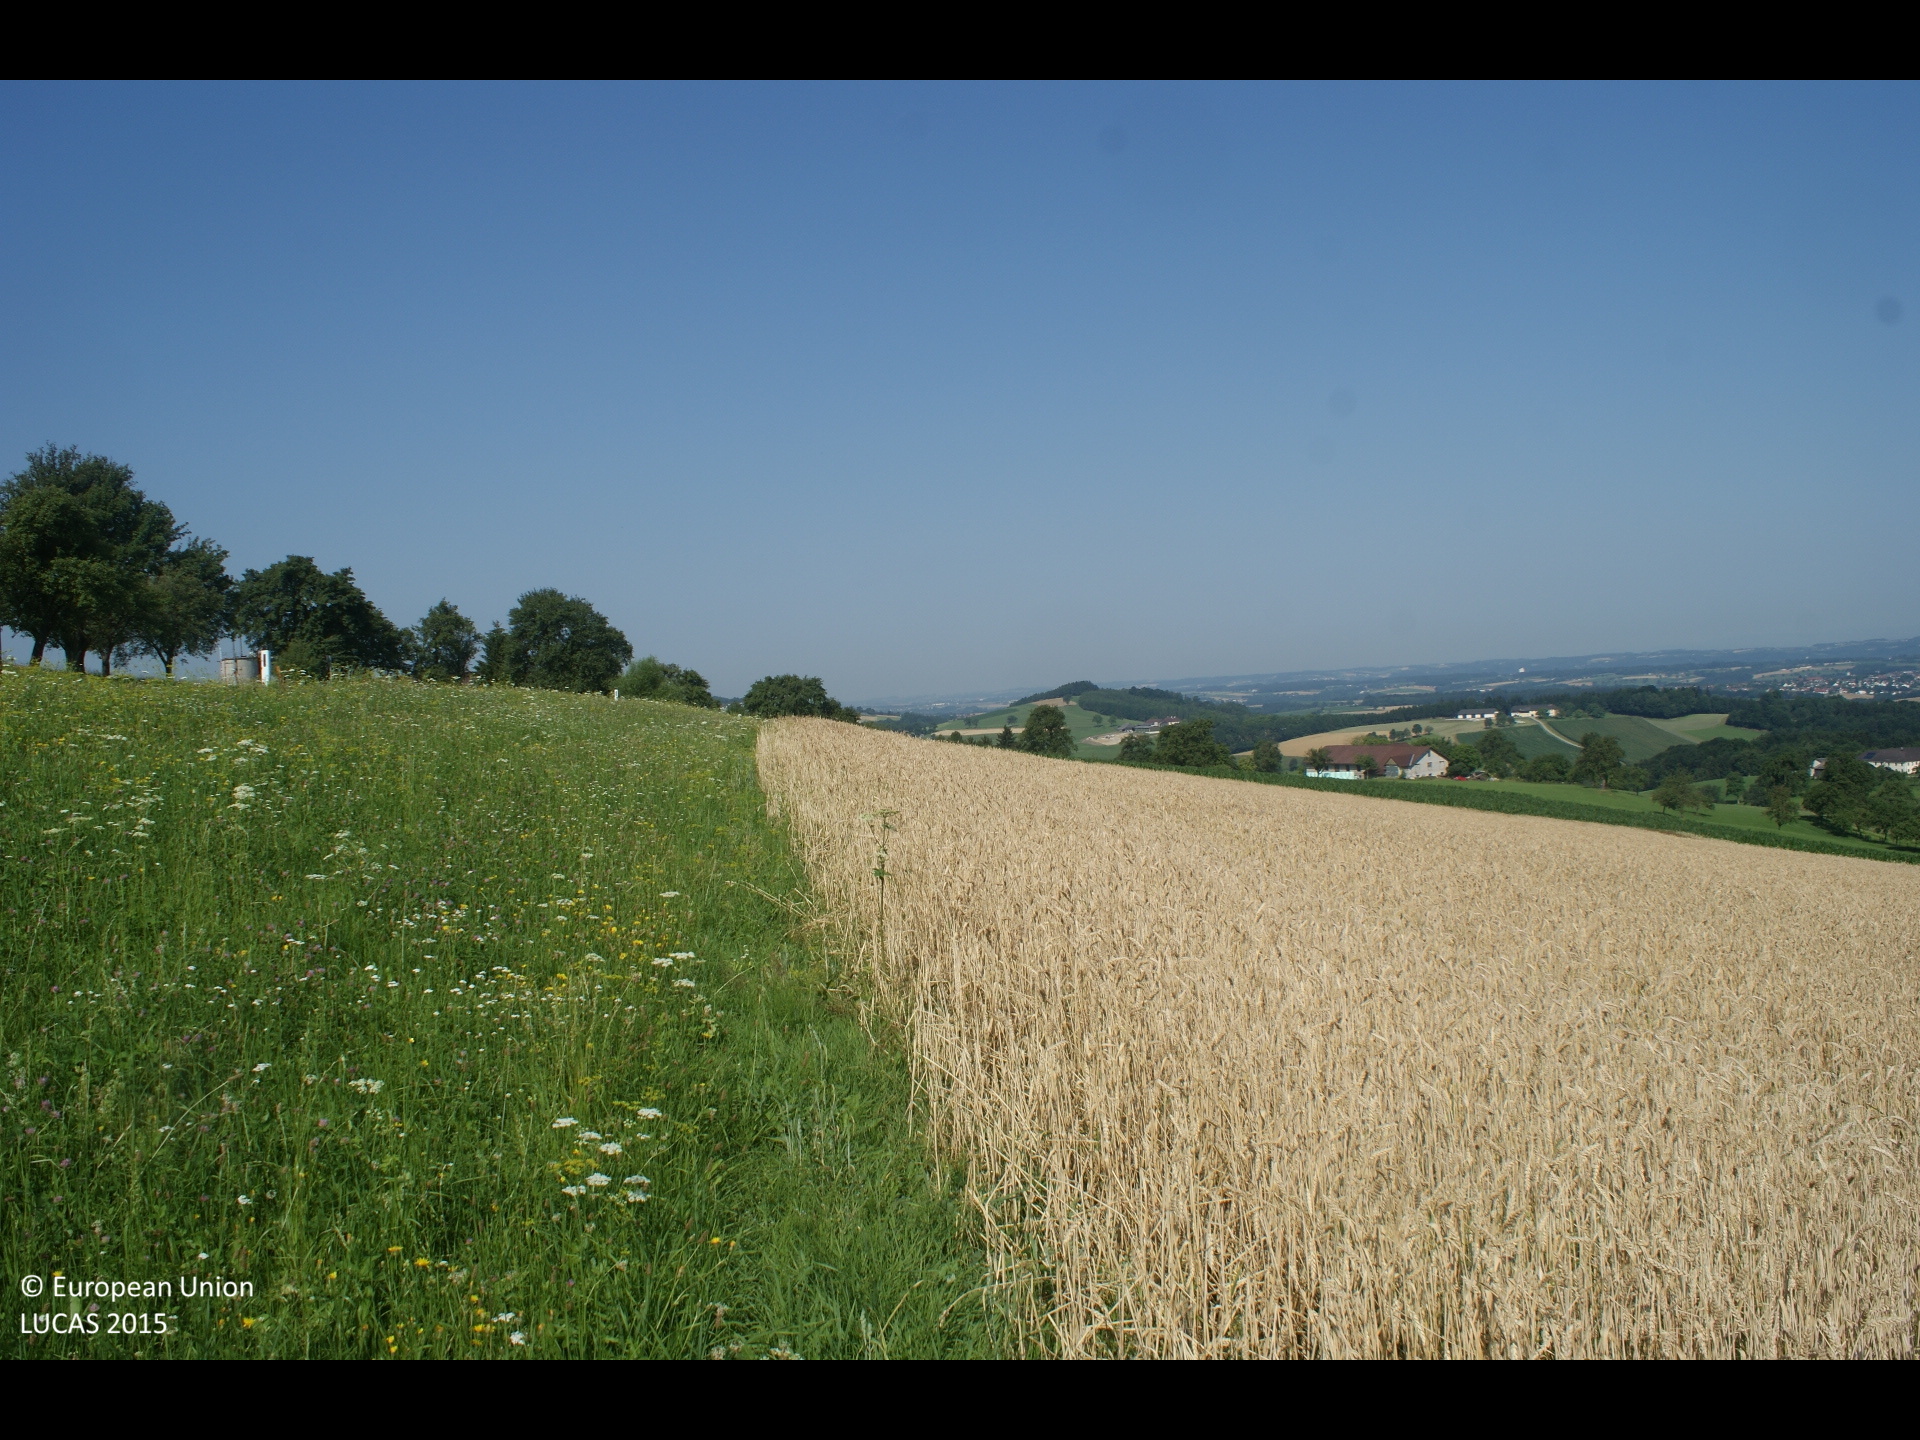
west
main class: Cropland
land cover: Common wheat
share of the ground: > 75 %
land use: Agriculture (excluding fallow land and kitchen gardens)
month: July
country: AT
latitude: 48.0570
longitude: 14.9787
